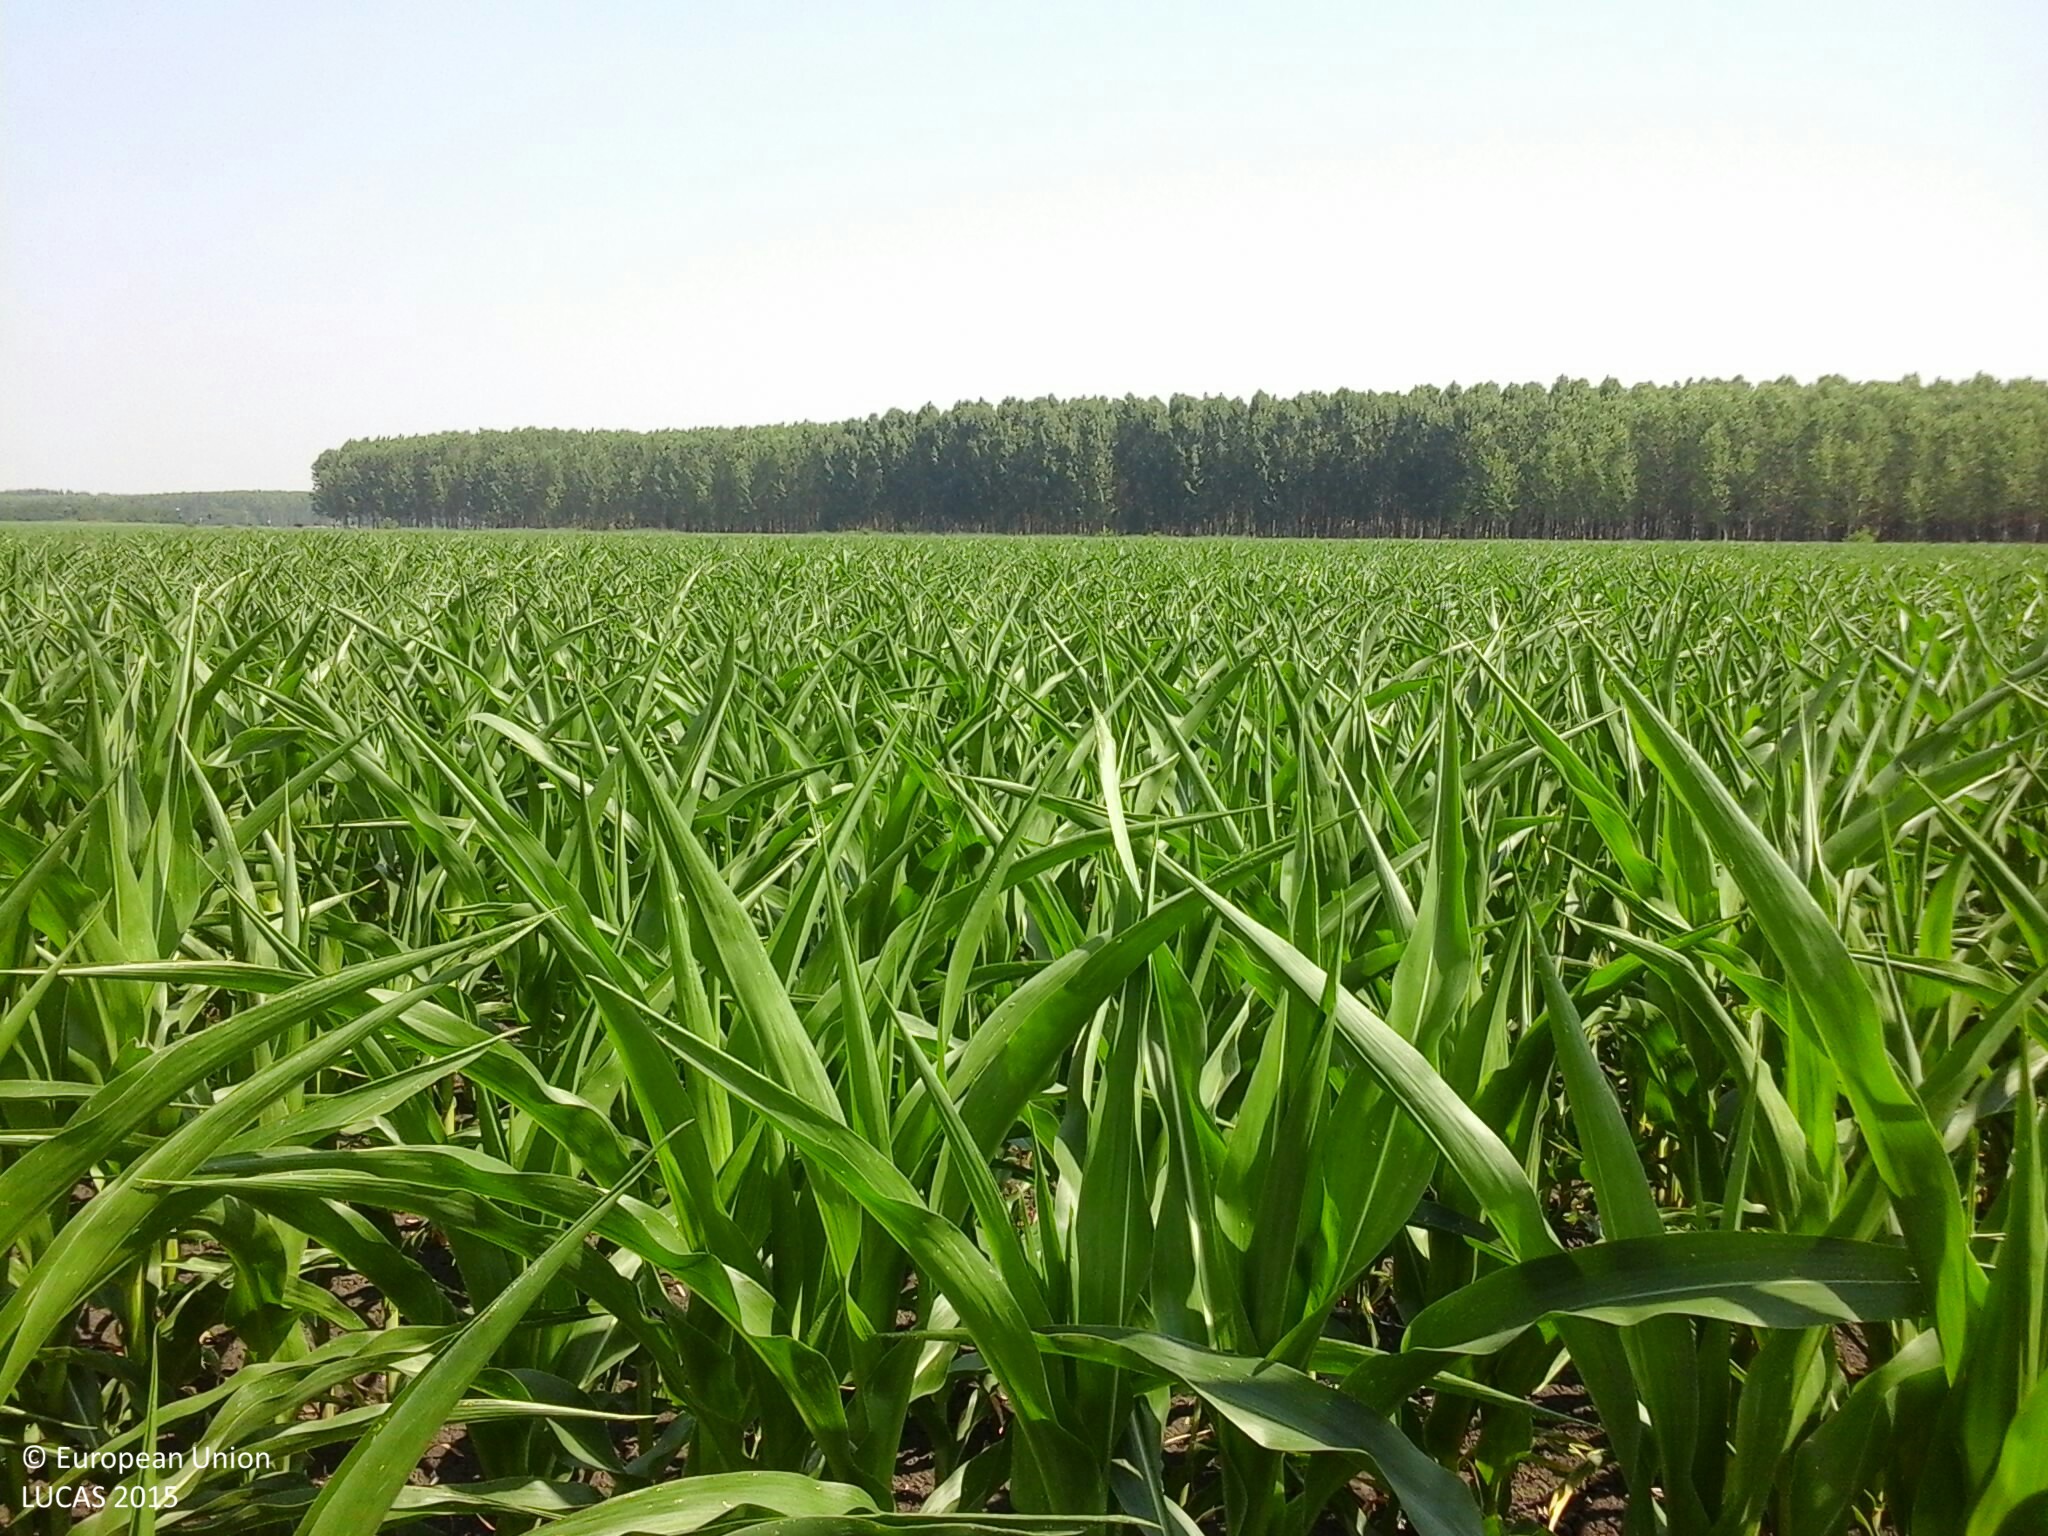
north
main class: Cropland
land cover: Maize
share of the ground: > 75 %
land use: Agriculture (excluding fallow land and kitchen gardens)
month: July
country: HU
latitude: 46.7722
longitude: 20.1737
